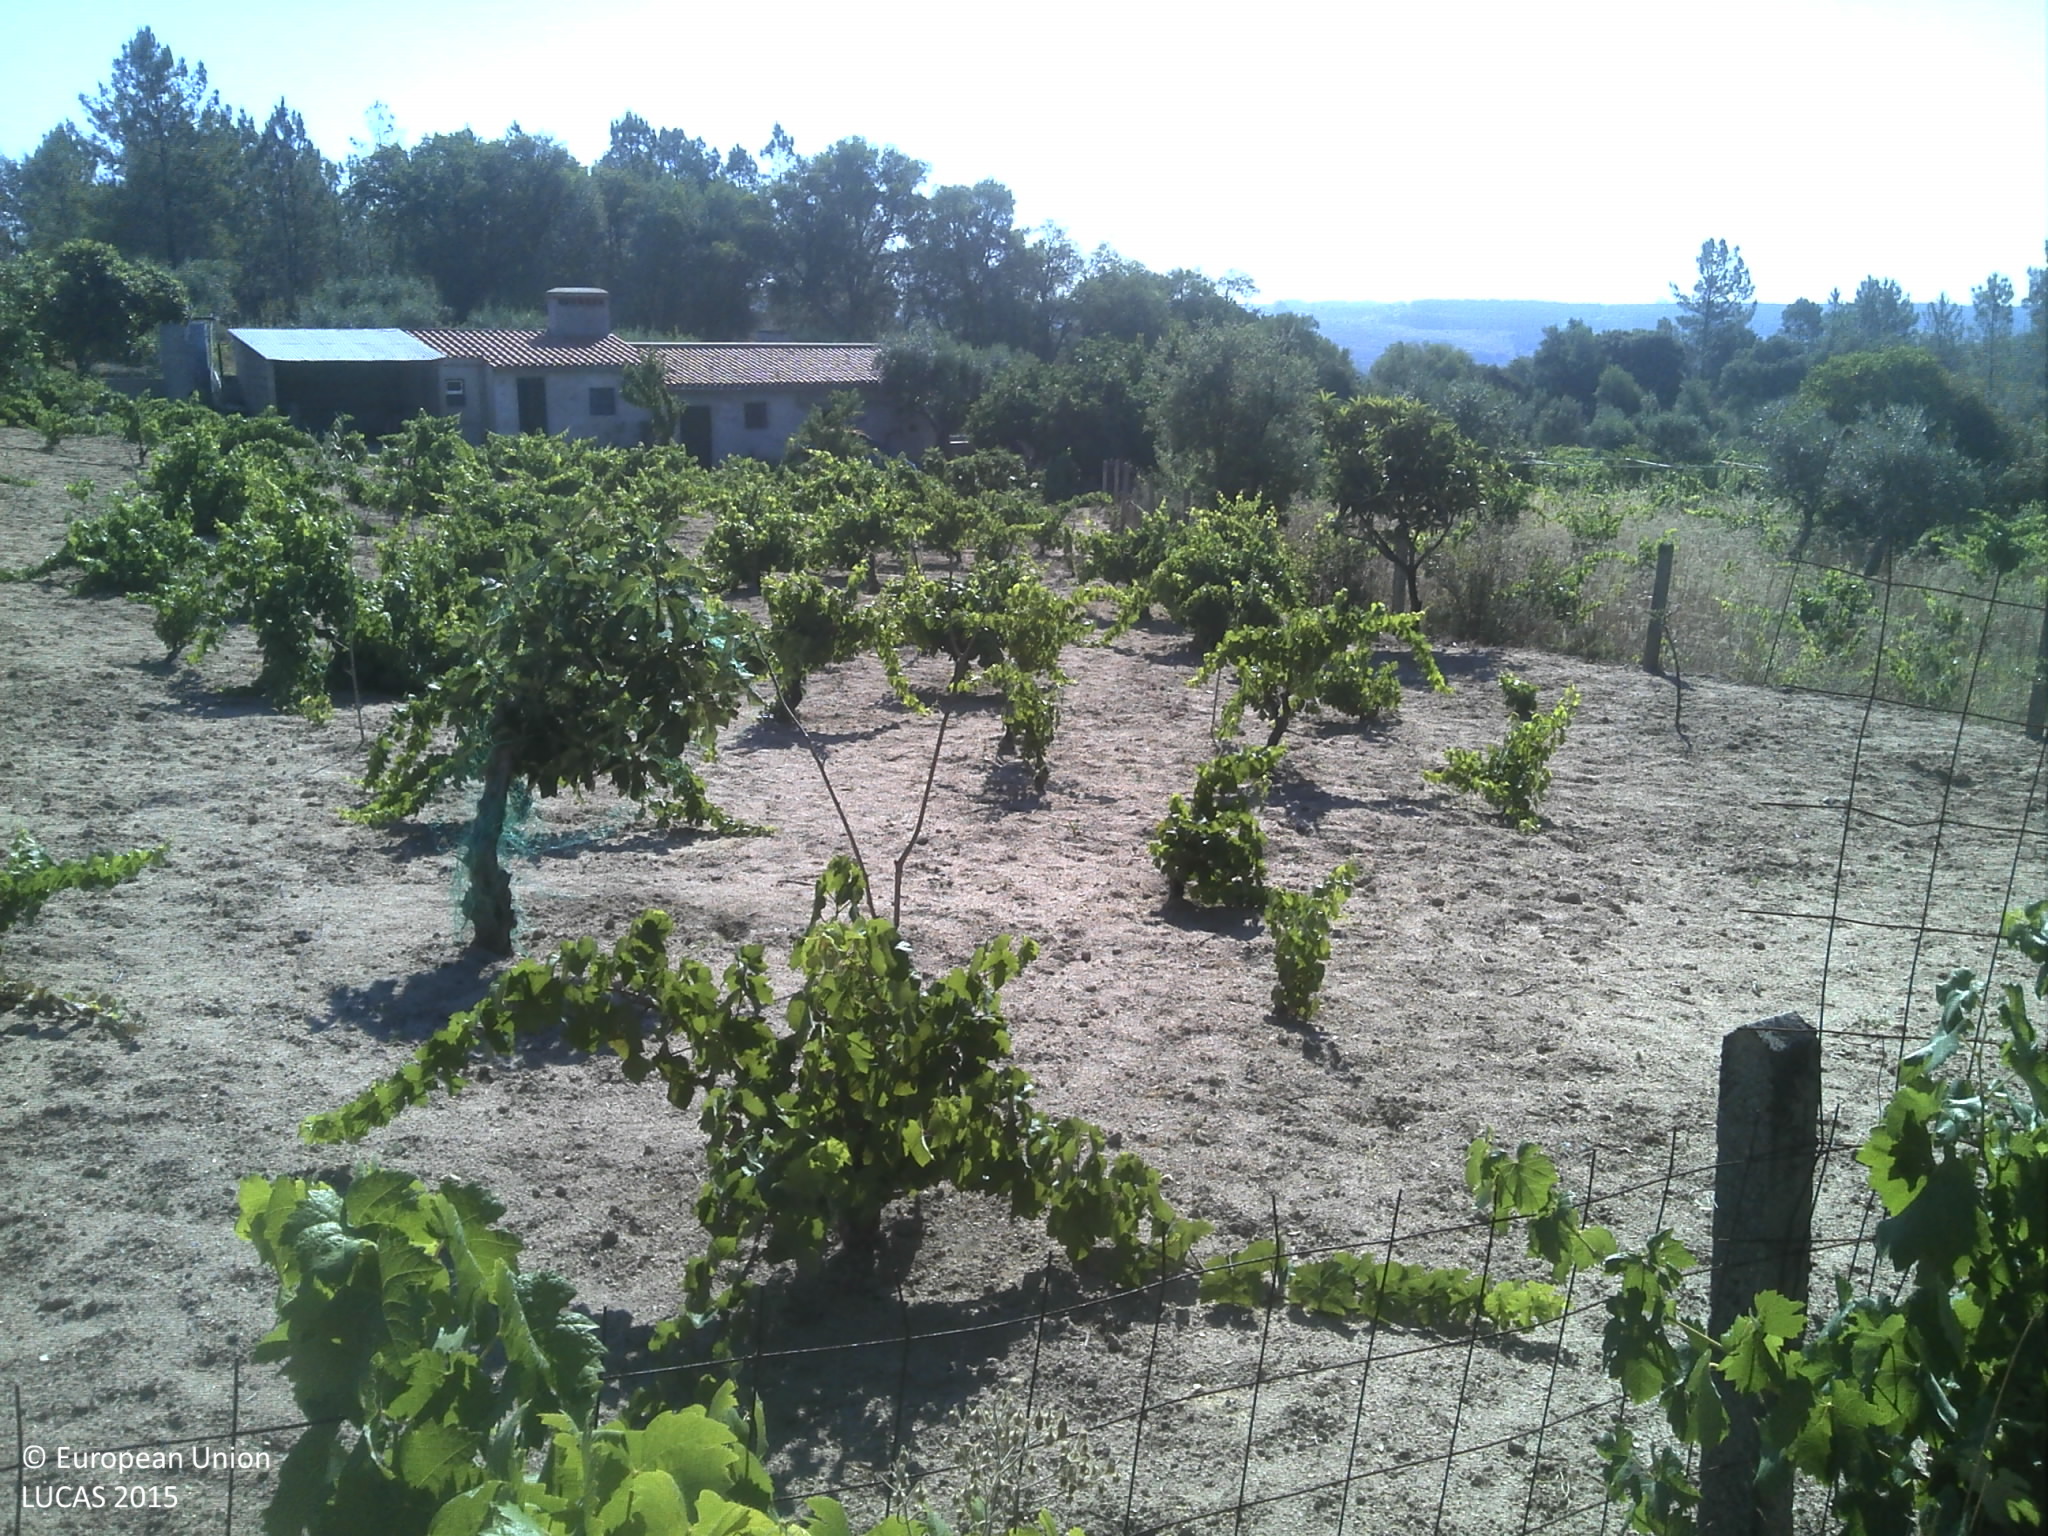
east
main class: Cropland
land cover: Olive groves
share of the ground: 25 - 50 %
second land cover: Vineyards
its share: 10 - 25 %
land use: Agriculture (excluding fallow land and kitchen gardens)
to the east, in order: Olive groves; Vineyards; Olive groves; Fences; Vineyards; Artificial constructions in urban areas; Grassland without tree/shrub cover; Fences; Potatoes; Fences; Grassland without tree/shrub cover; Broadleaved woodland; Shrubland without tree cover; Grassland without tree/shrub cover; Olive groves
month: June
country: PT
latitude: 39.8702
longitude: -7.5563
